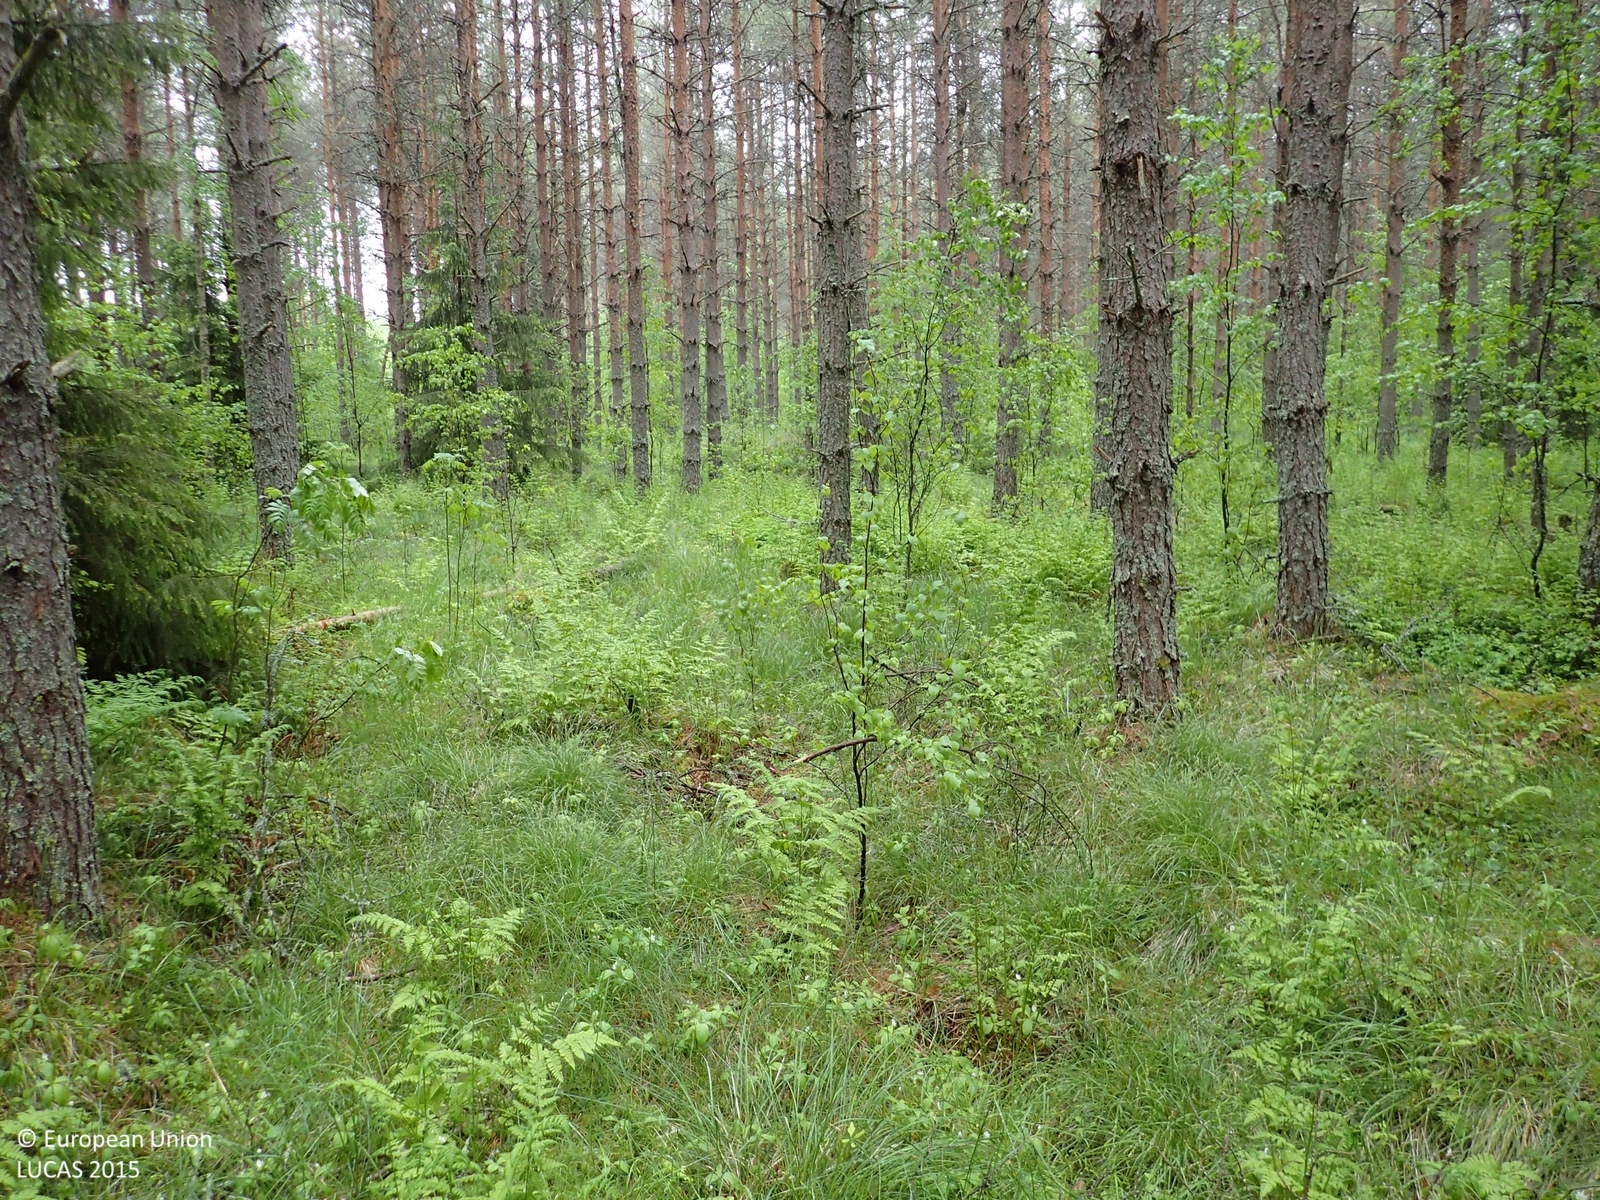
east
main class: Woodland
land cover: Pine dominated coniferous woodland
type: boreal forest
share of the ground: > 75 %
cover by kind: coniferous forest trees 70 %, herbaceous plants 25 %, broadleaved forest trees 5 %
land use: Forestry
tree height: > 5 m
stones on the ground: < 10 %
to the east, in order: Pine dominated coniferous woodland; Ditches and canals; Pine dominated coniferous woodland; Ditches and canals; Pine dominated coniferous woodland; Ditches and canals; Pine dominated coniferous woodland; Pine dominated mixed woodland; Ditches and canals; Pine dominated mixed woodland
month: June
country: FI
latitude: 62.4615
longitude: 22.6405
